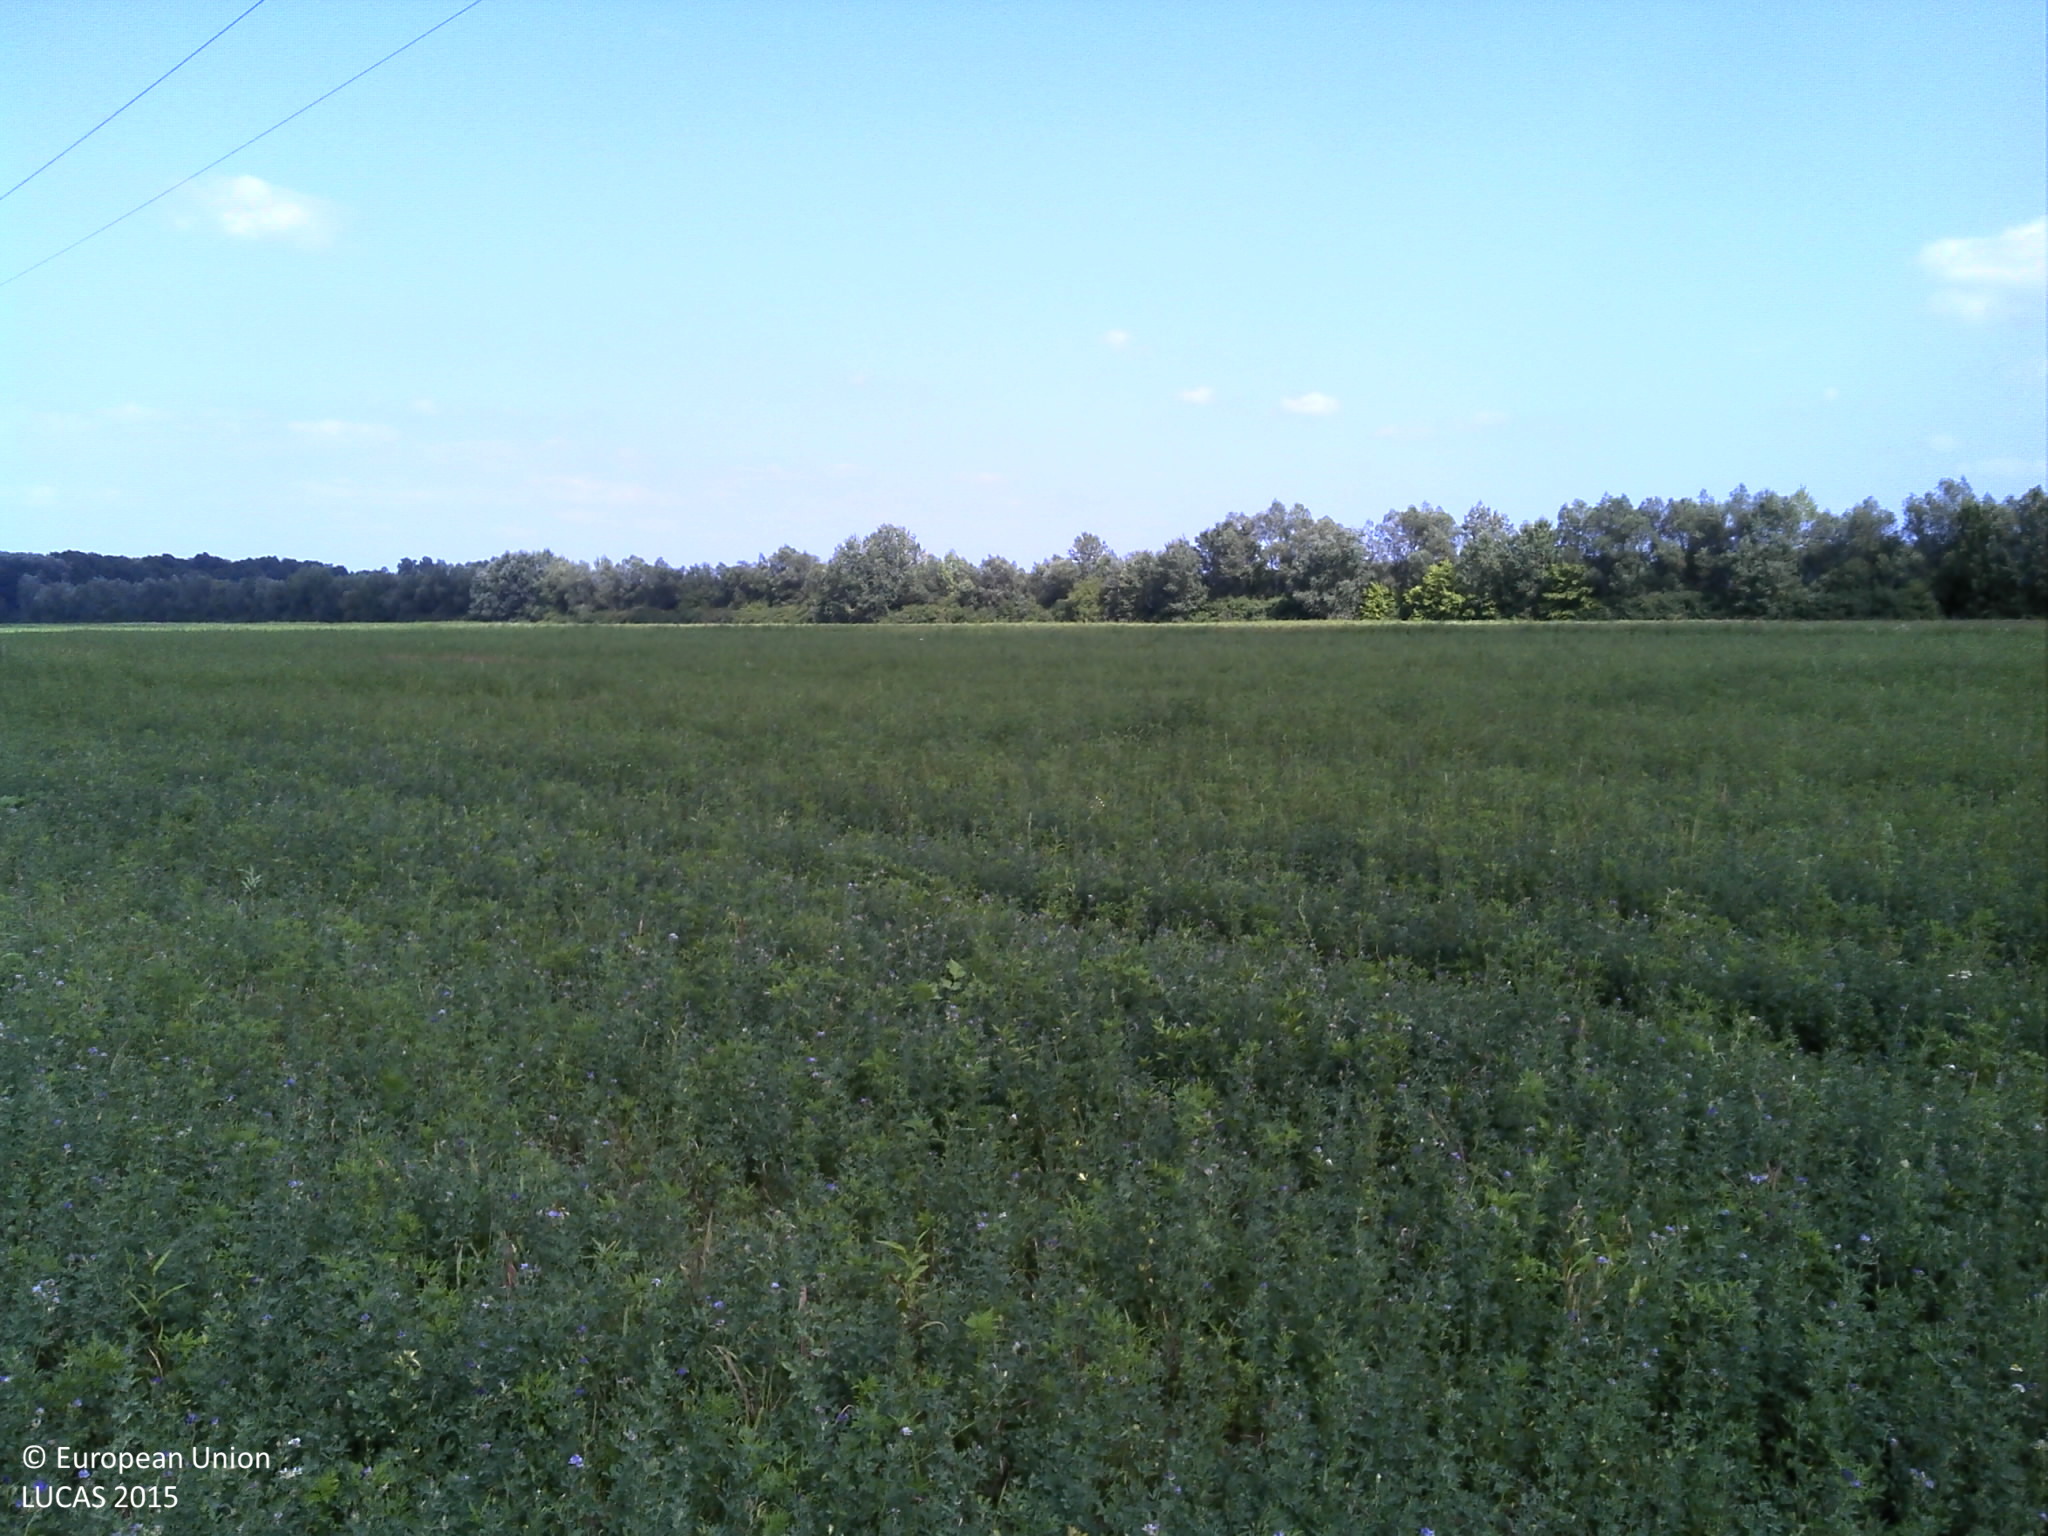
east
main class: Cropland
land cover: Clovers
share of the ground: > 75 %
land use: Agriculture (excluding fallow land and kitchen gardens)
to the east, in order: Clovers; Electric lines; Clovers; Spontaneously vegetated surfaces
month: August
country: HR
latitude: 45.4857
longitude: 16.4849
